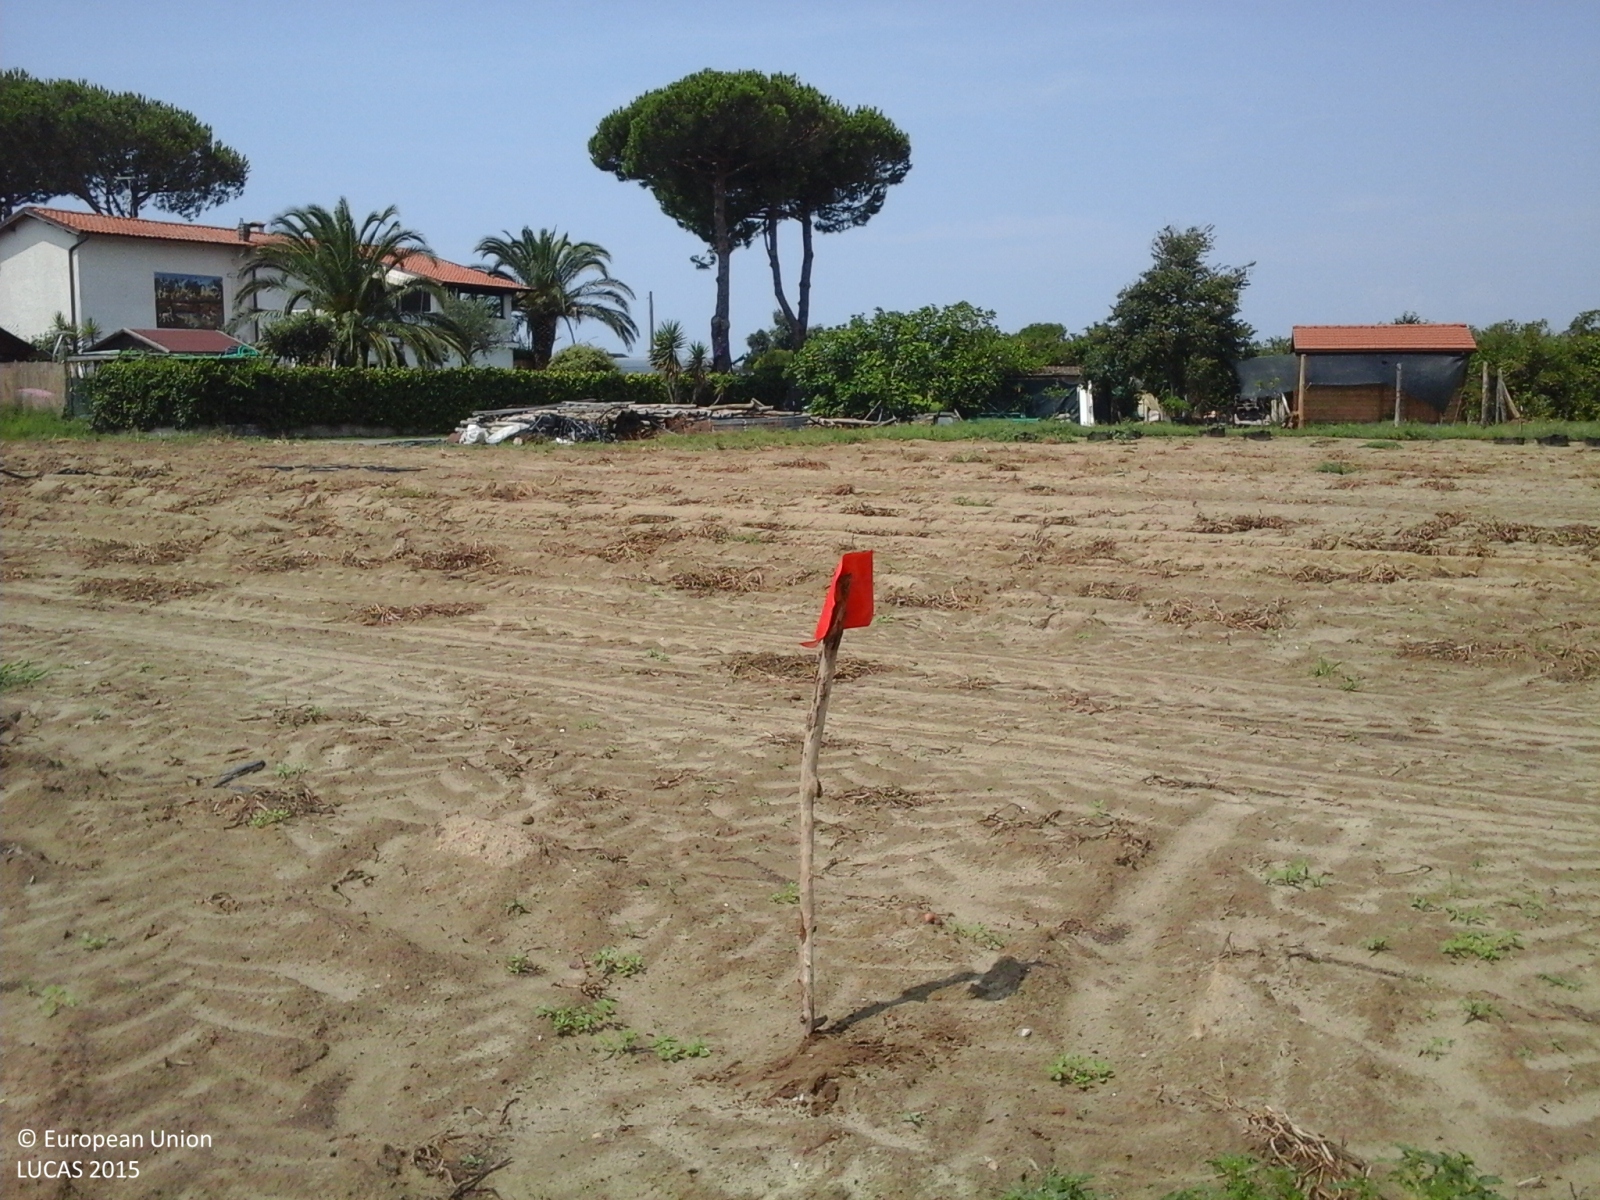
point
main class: Cropland
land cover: Potatoes
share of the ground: > 75 %
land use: Agriculture (excluding fallow land and kitchen gardens)
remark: Harvested field
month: August
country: IT
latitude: 43.9173
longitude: 10.2360
